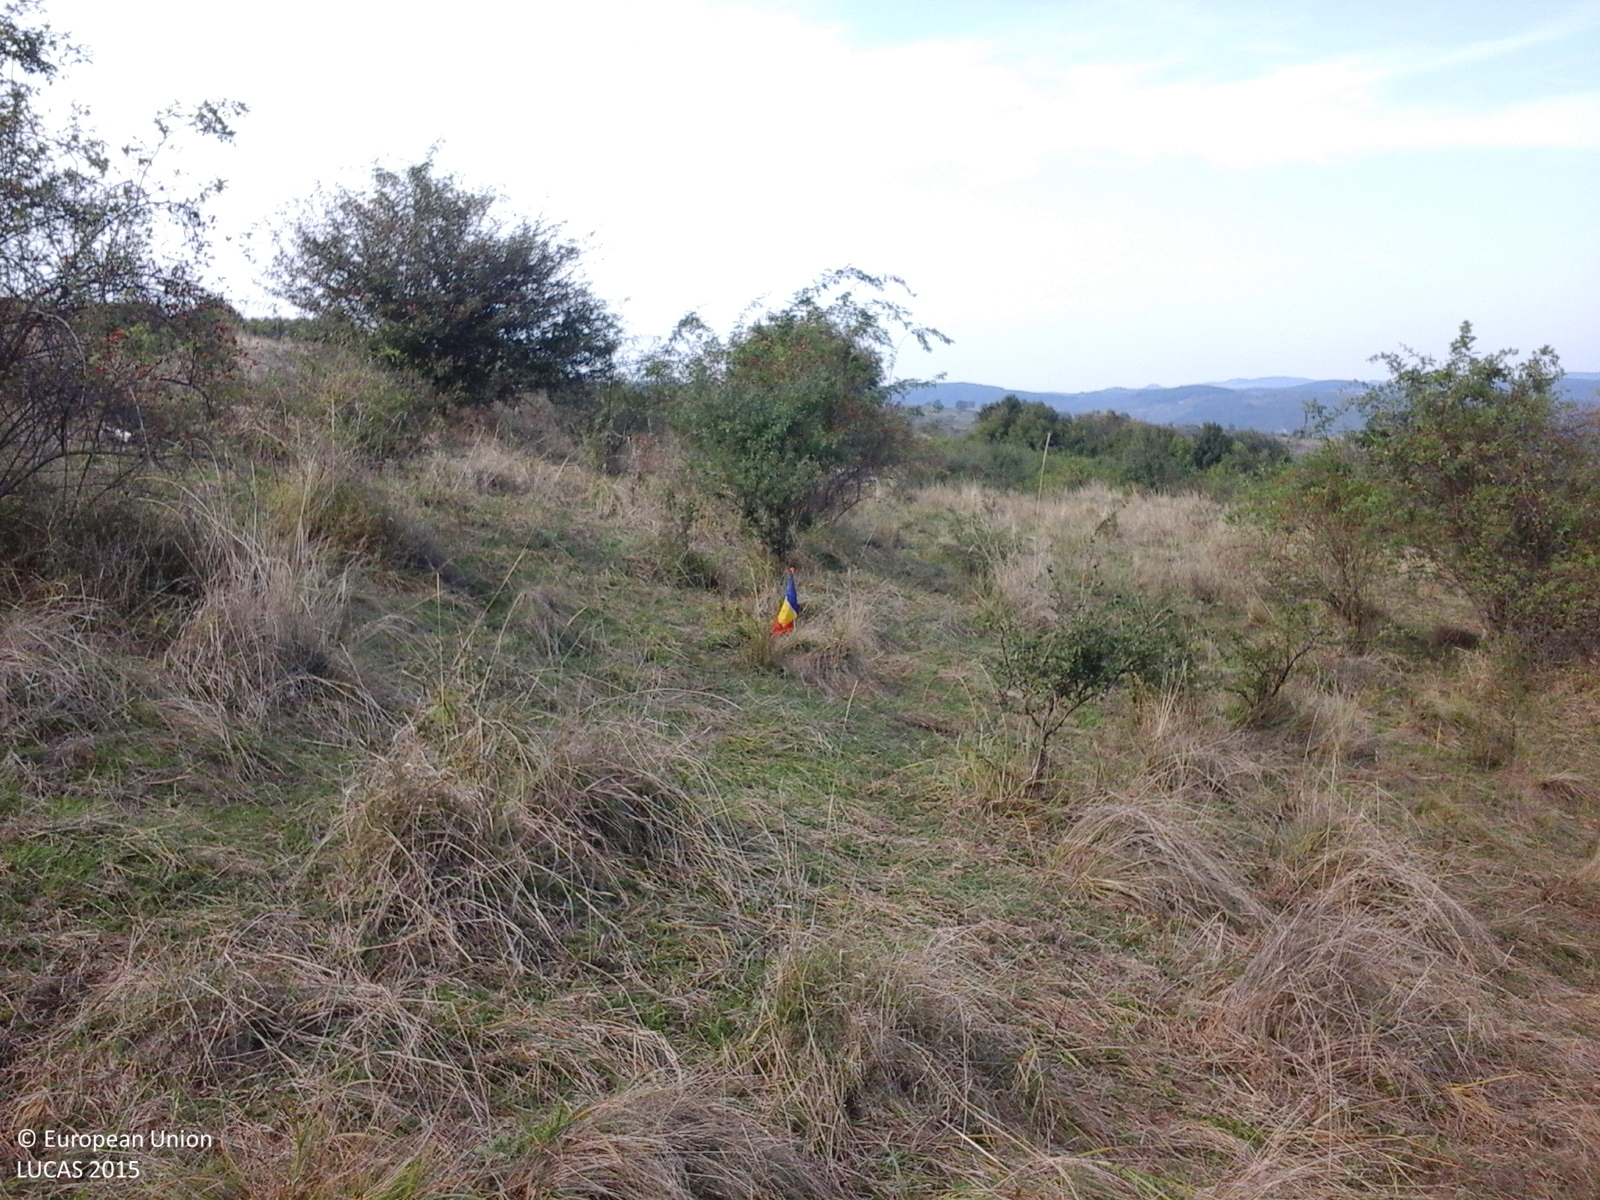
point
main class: Grassland
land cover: Grassland with sparse tree/shrub cover
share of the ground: > 75 %
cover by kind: herbaceous plants 85 %, shrubs 10 %, broadleaved forest trees 5 %
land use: Agriculture (excluding fallow land and kitchen gardens)
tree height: < 5 m
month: September
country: RO
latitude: 47.1125
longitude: 23.6618
